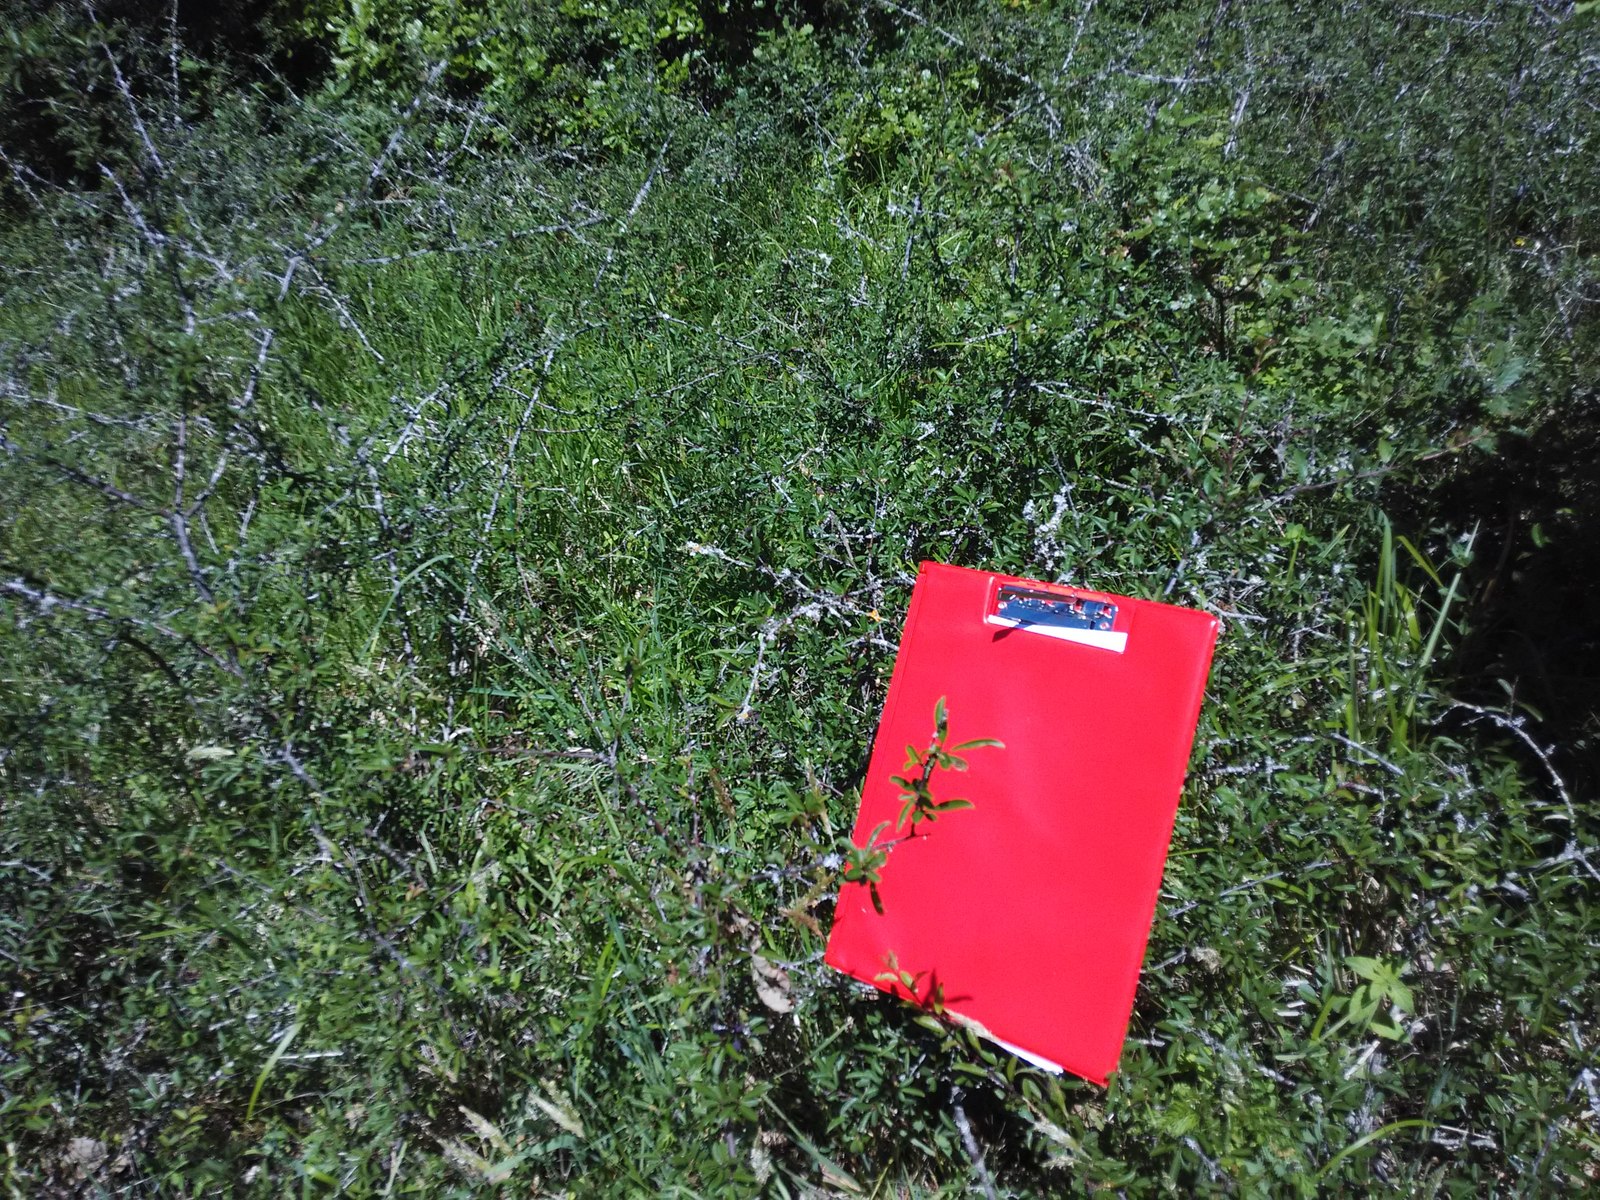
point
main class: Shrubland
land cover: Shrubland with sparse tree cover
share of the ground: > 75 %
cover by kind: shrubs 65 %, herbaceous plants 30 %, broadleaved forest trees 5 %
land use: Forestry
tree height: > 5 m
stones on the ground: < 10 %
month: May
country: ES
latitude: 42.7615
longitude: -2.4258
